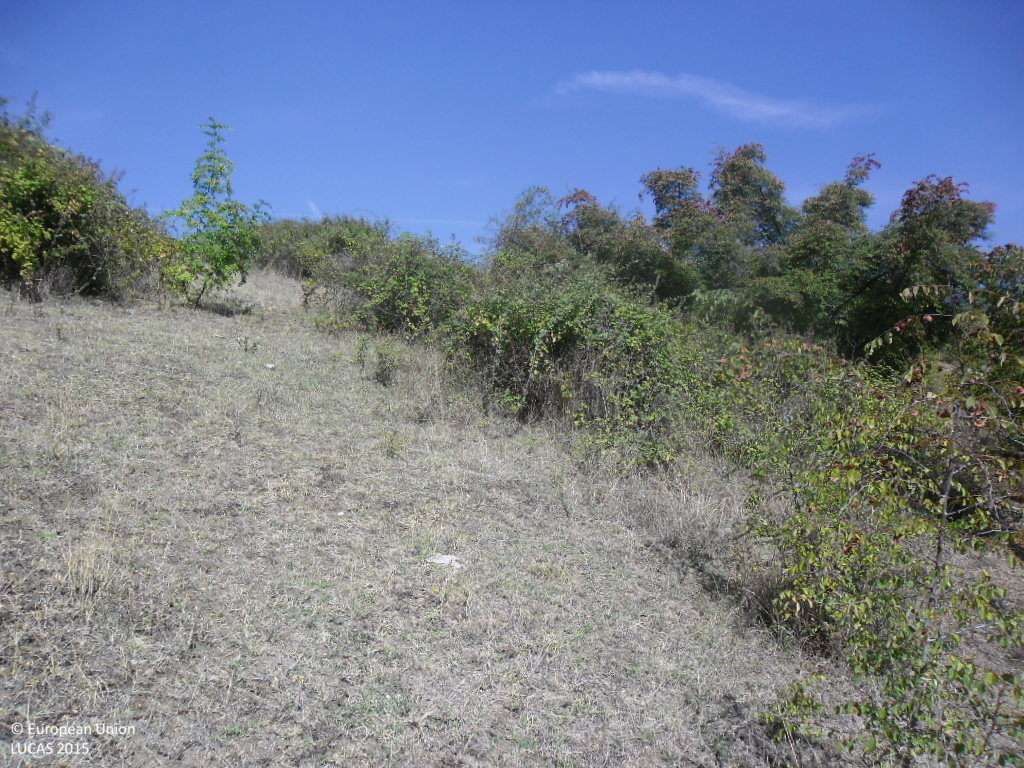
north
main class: Grassland
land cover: Grassland with sparse tree/shrub cover
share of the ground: > 75 %
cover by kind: herbaceous plants 90 %, broadleaved forest trees 5 %, shrubs 5 %
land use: Agriculture (excluding fallow land and kitchen gardens)
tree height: < 5 m
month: September
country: BG
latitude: 41.5622
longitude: 23.3690
